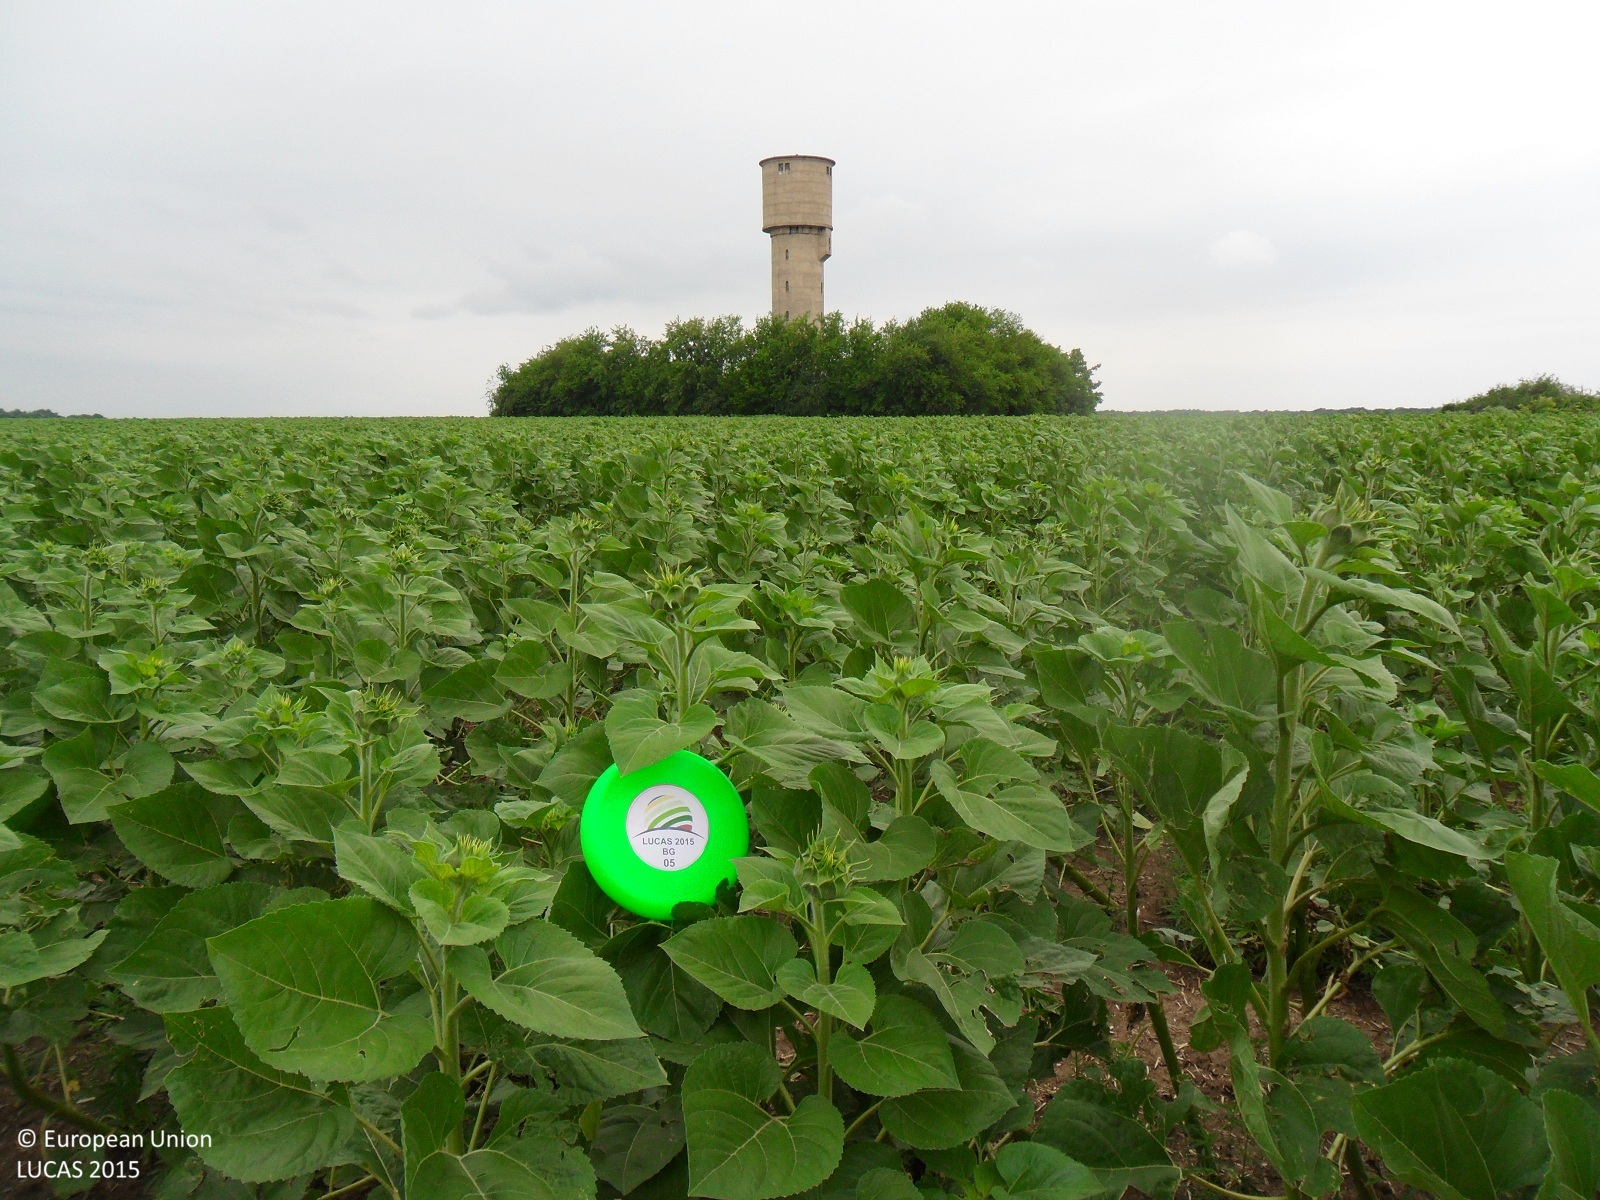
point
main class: Cropland
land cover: Sunflower
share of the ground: > 75 %
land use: Agriculture (excluding fallow land and kitchen gardens)
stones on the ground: < 10 %
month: June
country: BG
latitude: 43.8130
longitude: 26.8122
